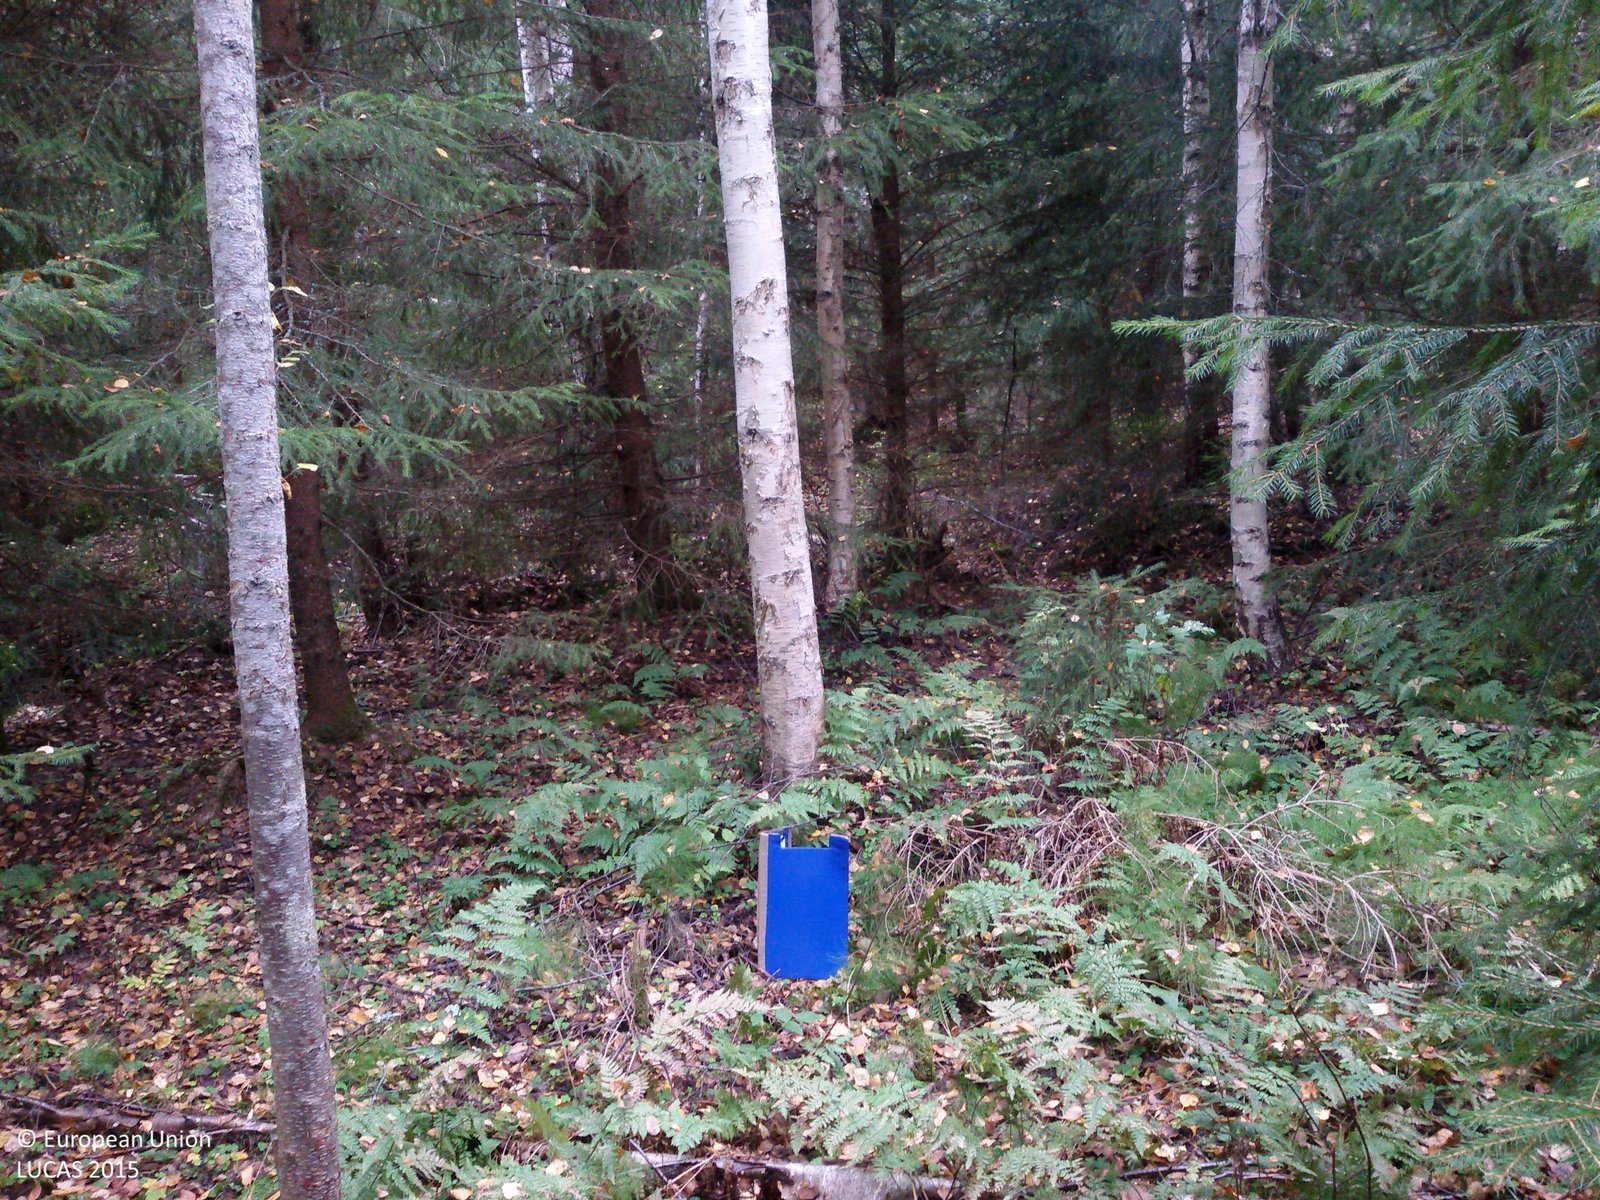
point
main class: Woodland
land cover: Spruce dominated mixed woodland
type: boreal forest
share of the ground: > 75 %
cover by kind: coniferous forest trees 50 %, broadleaved forest trees 30 %, herbaceous plants 10 %, lichens and mosses 10 %
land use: Forestry
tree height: > 5 m
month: September
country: SE
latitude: 60.7072
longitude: 14.9526
